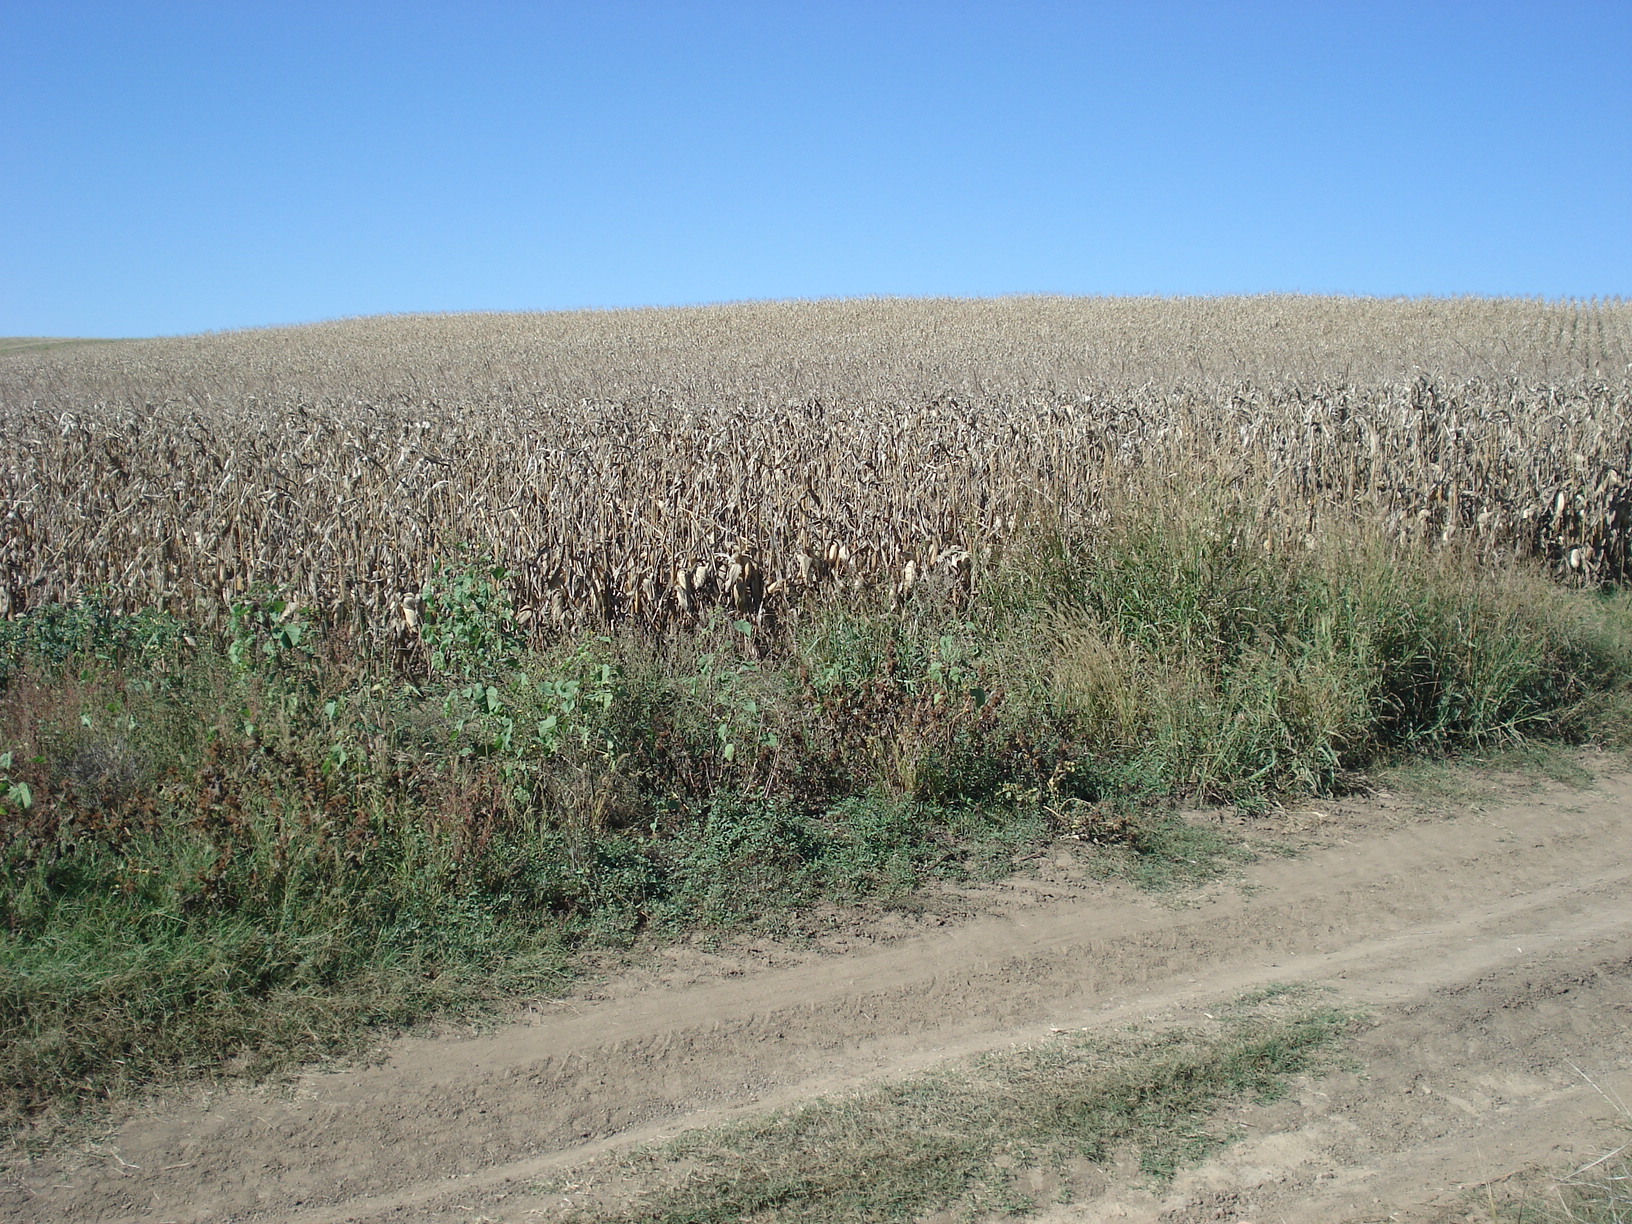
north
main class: Cropland
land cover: Maize
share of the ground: > 75 %
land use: Agriculture (excluding fallow land and kitchen gardens)
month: September
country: BG
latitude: 43.3211
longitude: 25.2792
